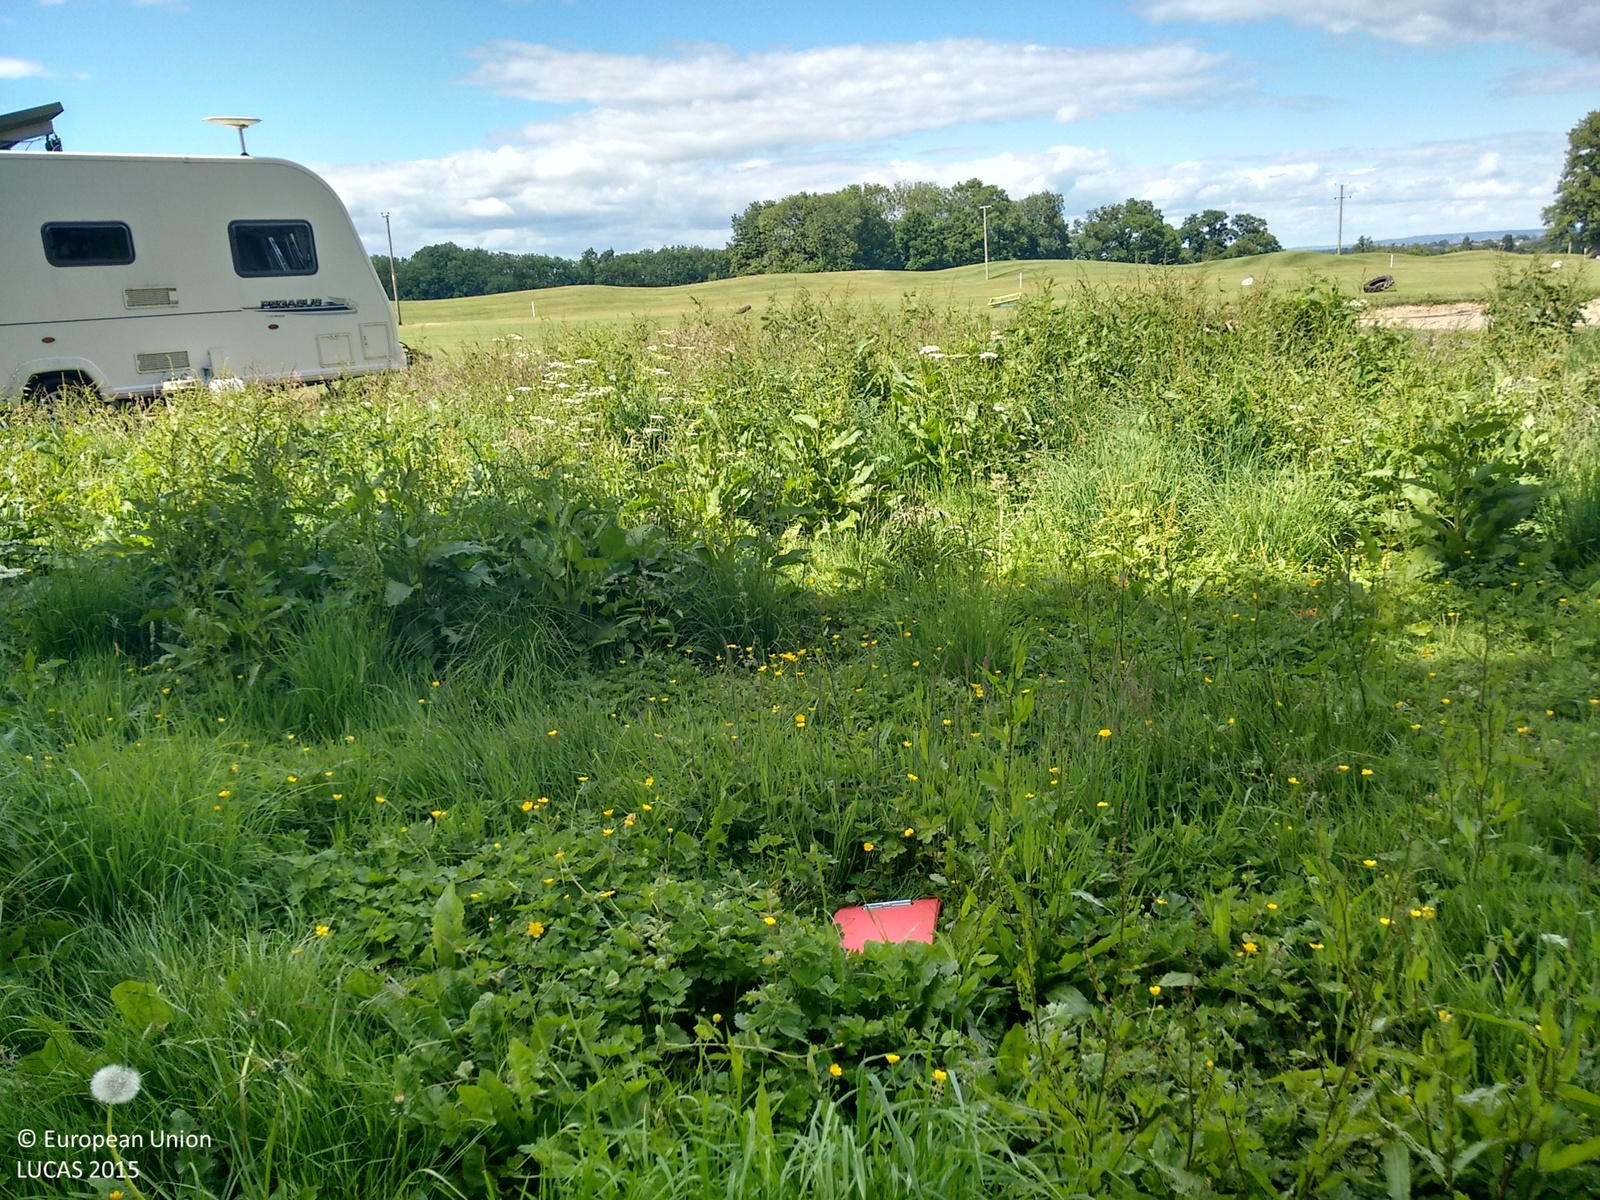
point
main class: Grassland
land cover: Spontaneously vegetated surfaces
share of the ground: > 75 %
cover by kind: herbaceous plants 100 %
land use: Sport
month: June
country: GB
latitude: 51.2601
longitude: -2.3157
